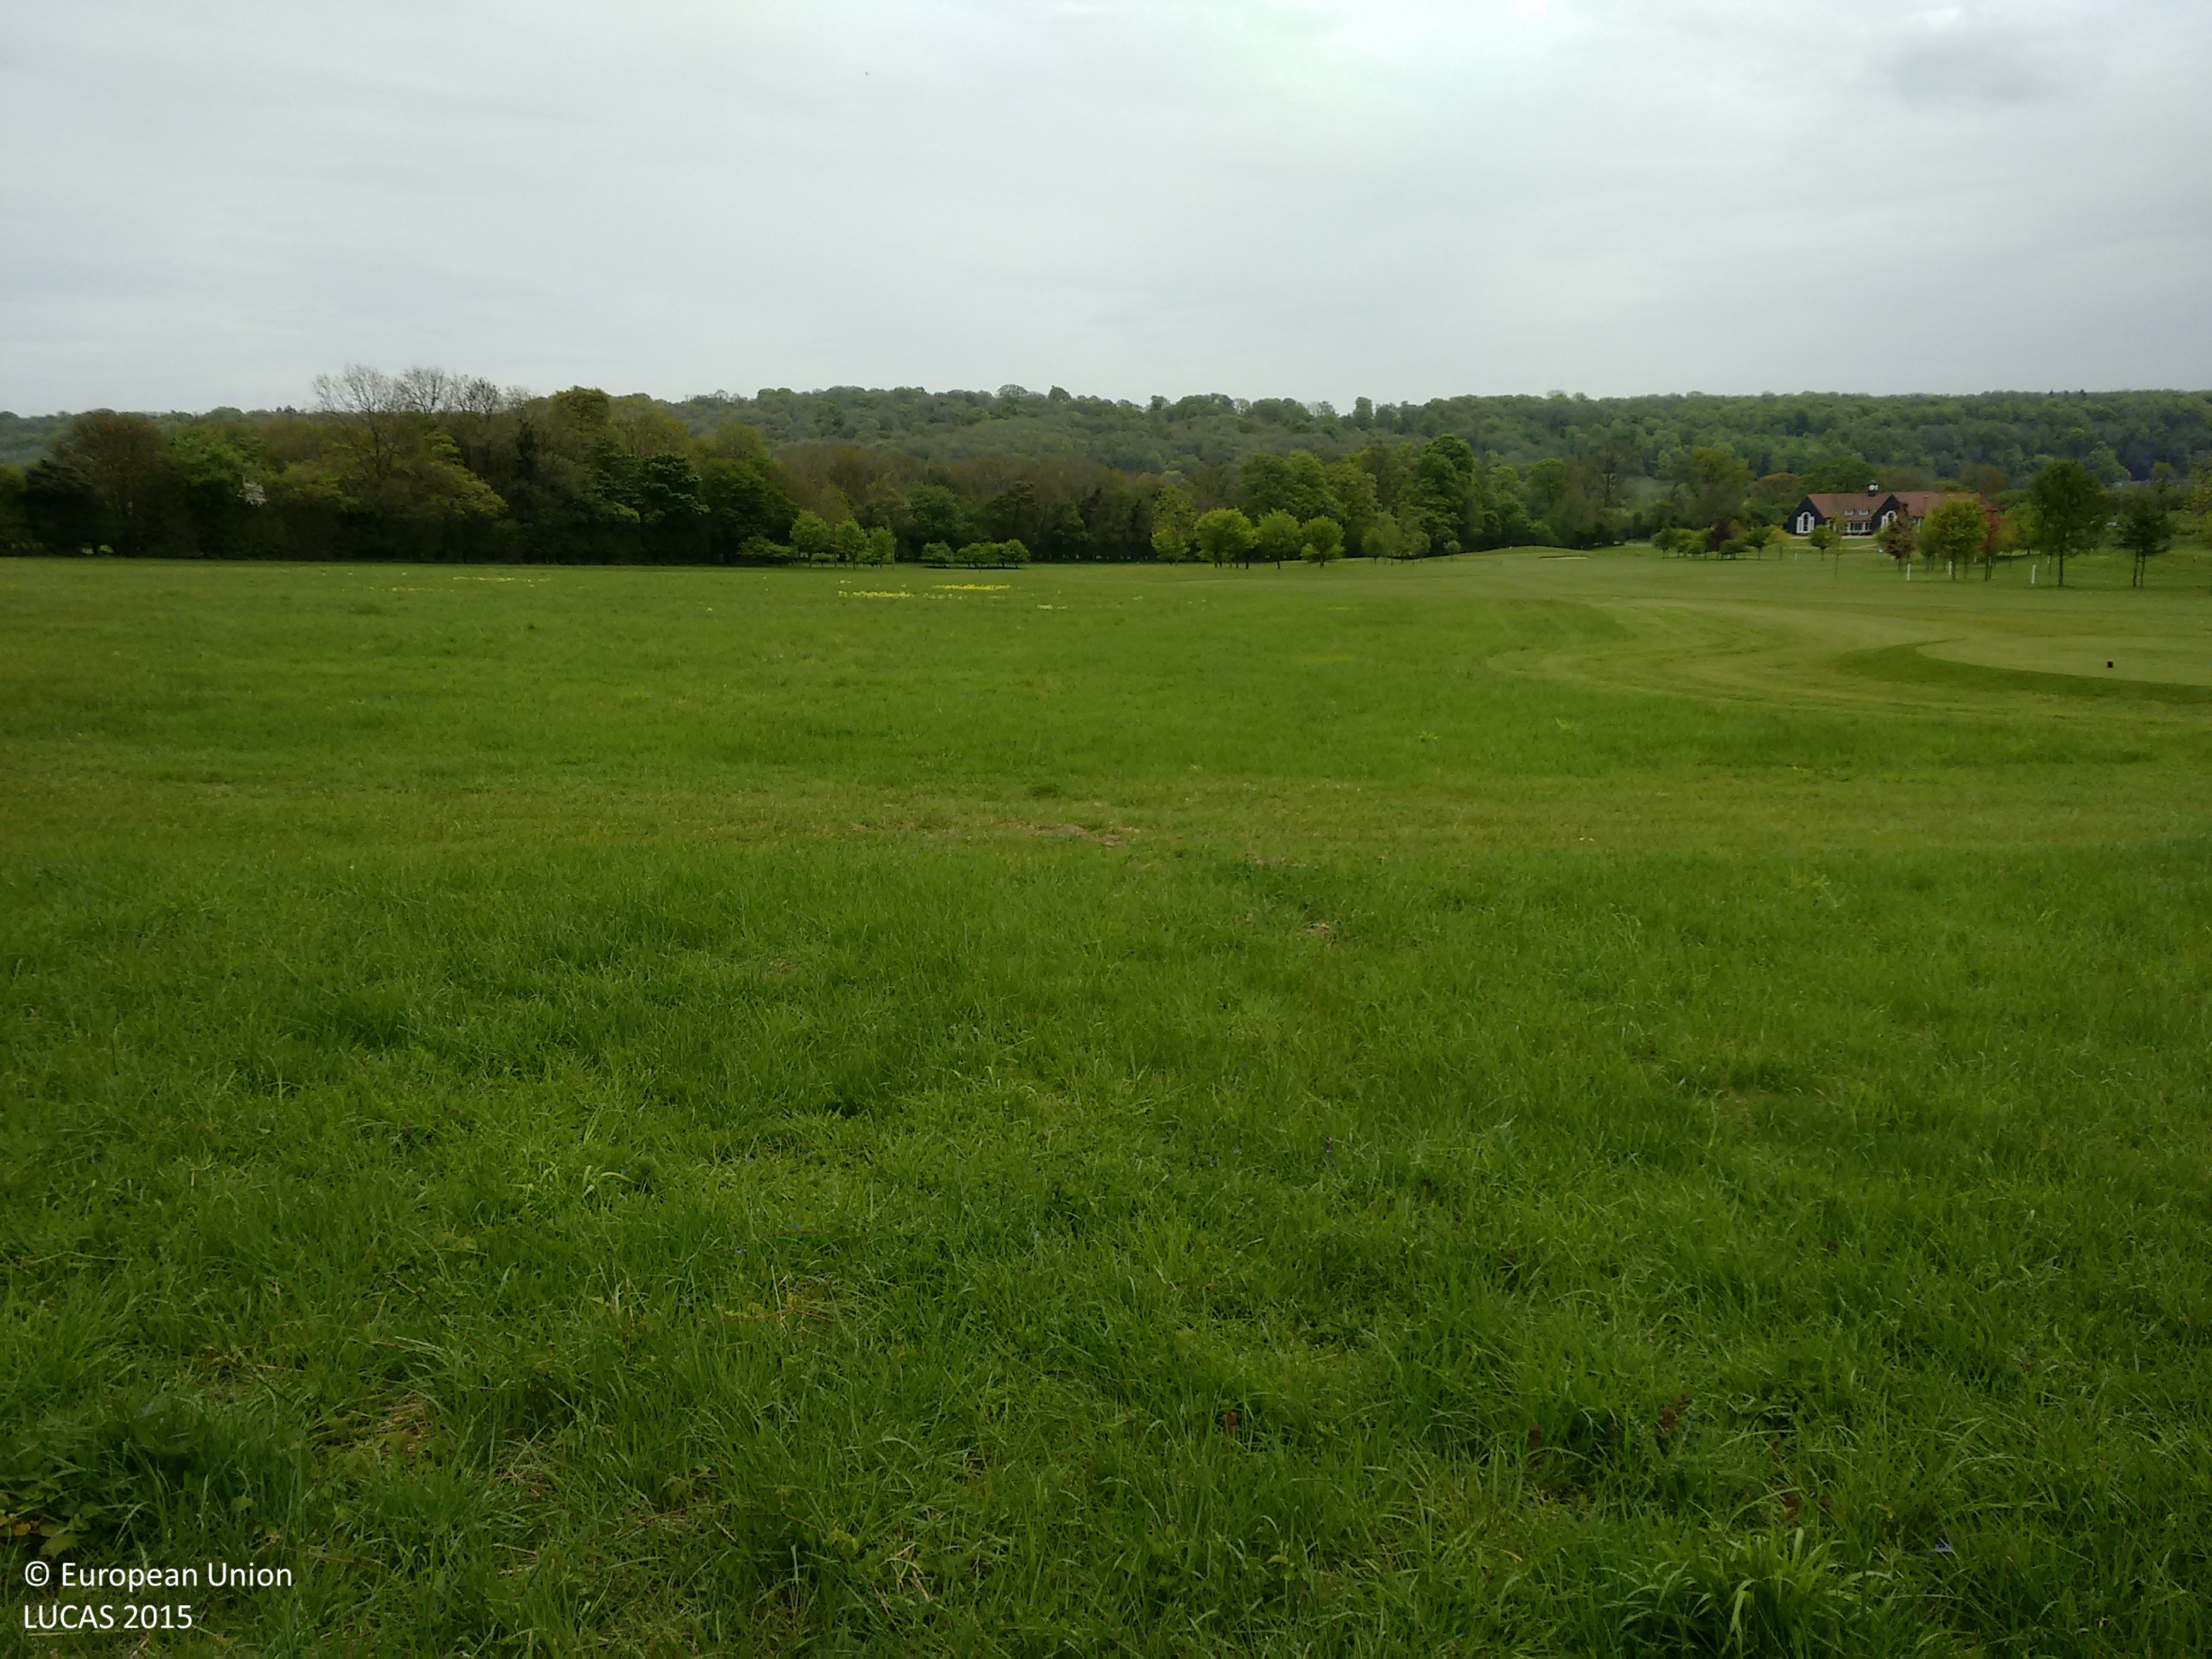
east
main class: Grassland
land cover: Grassland without tree/shrub cover
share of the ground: > 75 %
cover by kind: herbaceous plants 100 %
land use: Sport
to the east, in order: Grassland without tree/shrub cover
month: May
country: GB
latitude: 51.8096
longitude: -0.6133
